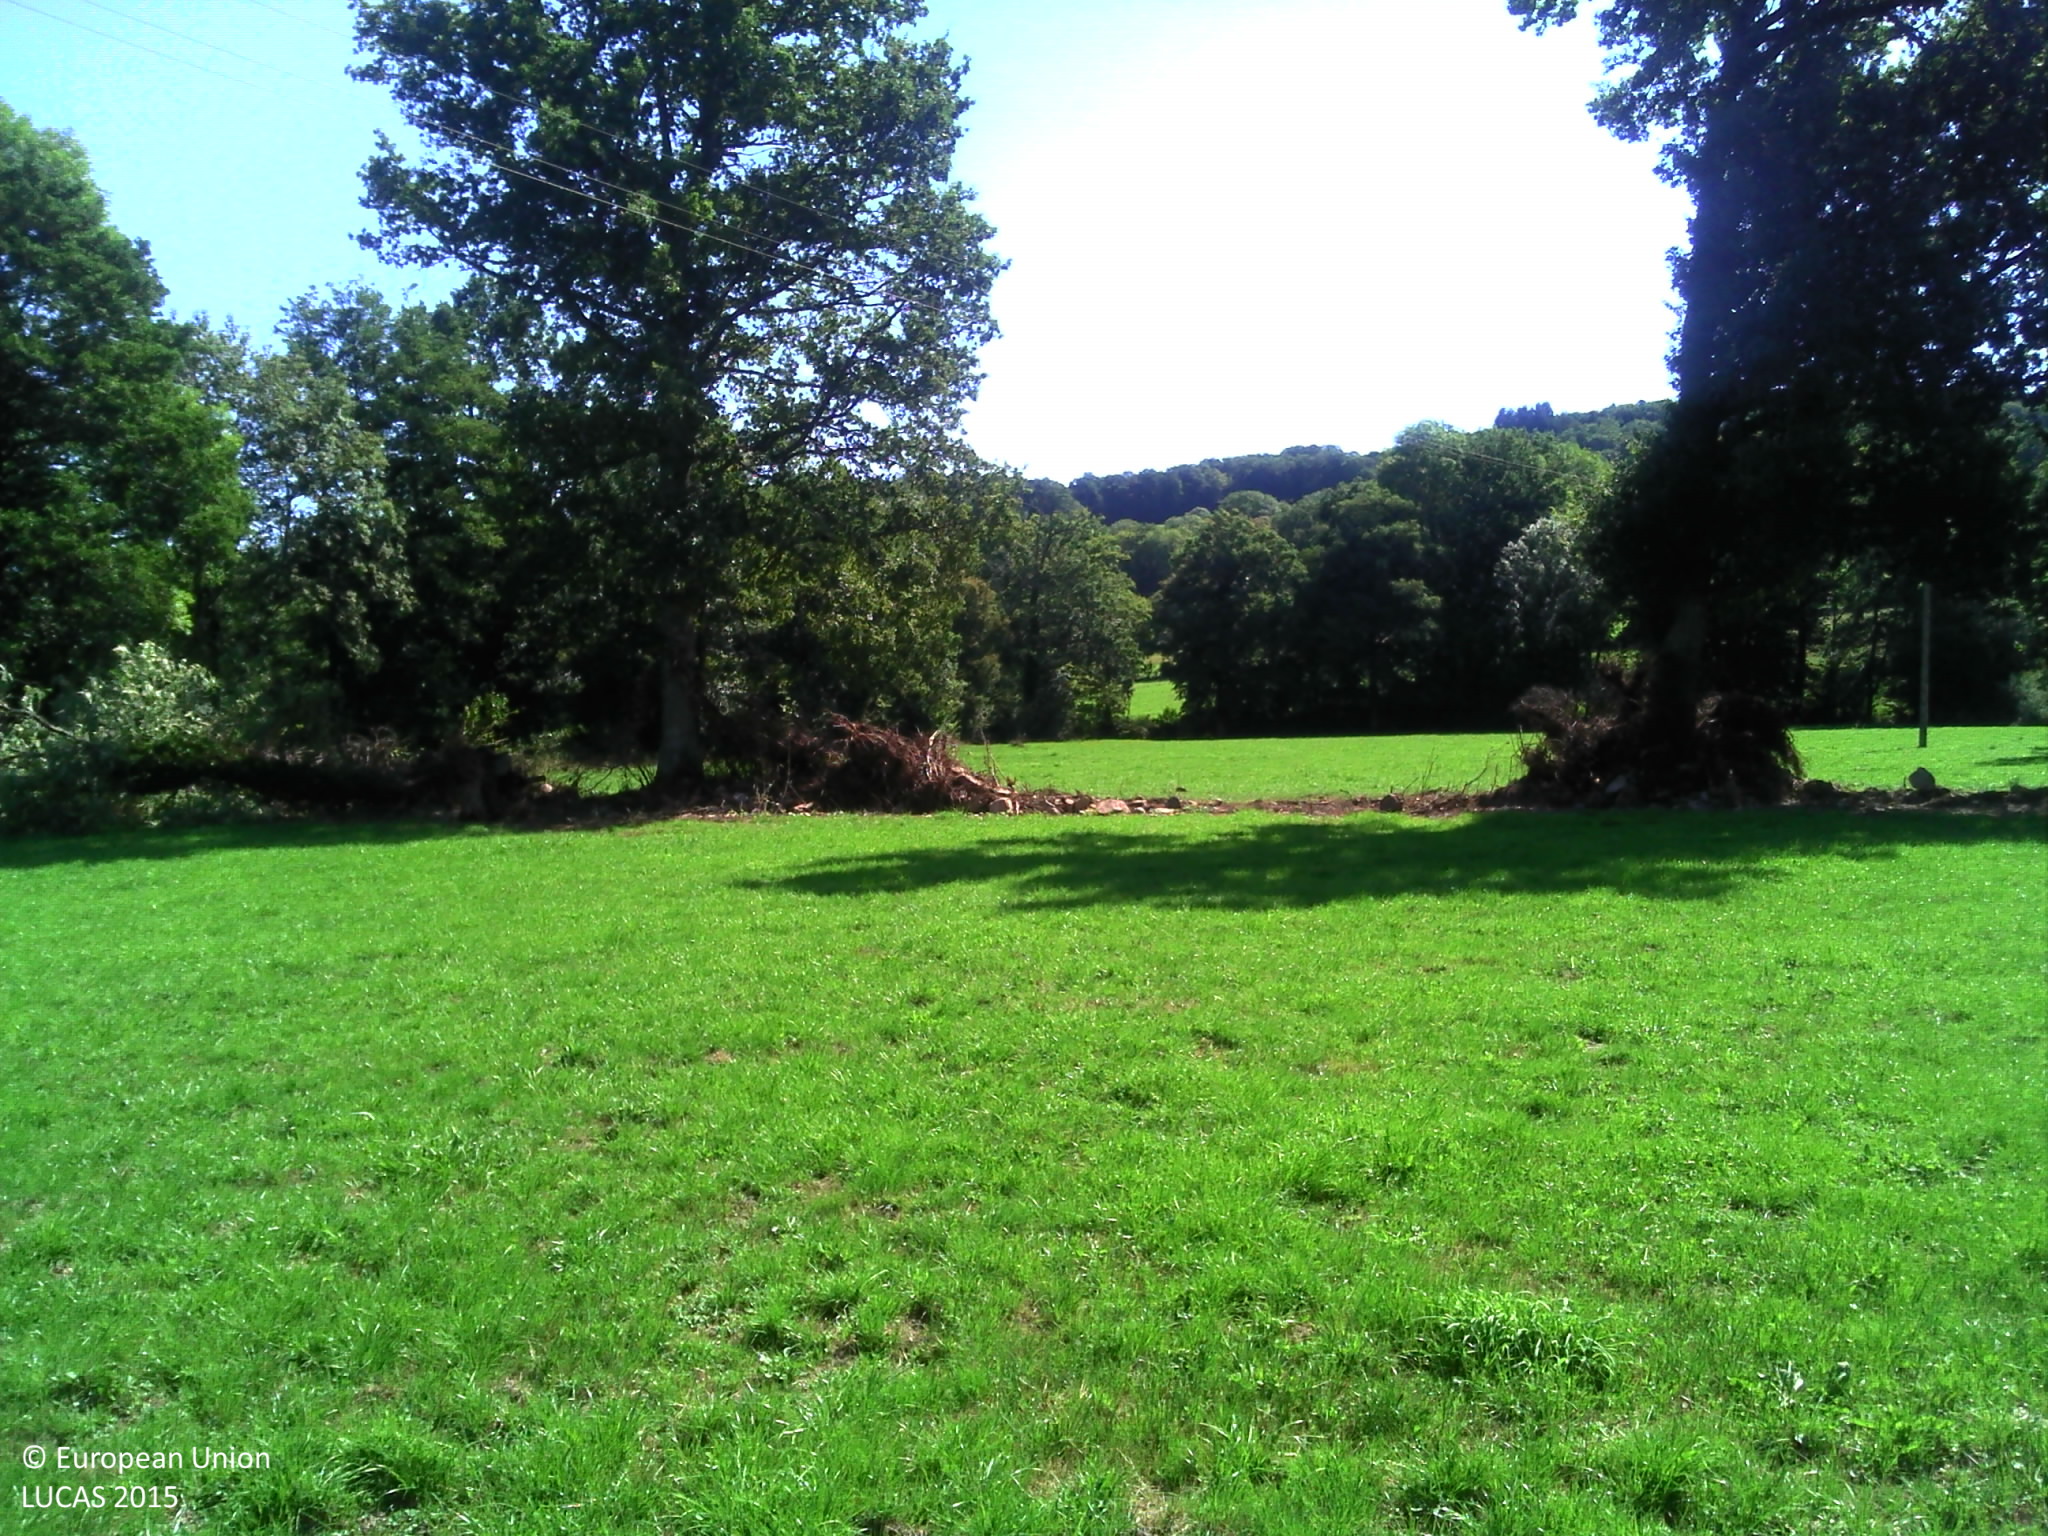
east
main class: Grassland
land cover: Grassland without tree/shrub cover
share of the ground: > 75 %
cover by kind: herbaceous plants 100 %
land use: Agriculture (excluding fallow land and kitchen gardens)
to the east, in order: Grassland without tree/shrub cover; Other bare soil; Electric lines; Grassland without tree/shrub cover; Fences; Rivers and streams; Broadleaved woodland; Fences; Grassland without tree/shrub cover; Fences; Broadleaved woodland; Inland fresh running water; Abandoned hedges; Fences; Grassland without tree/shrub cover; Ditches and canals; Grassland without tree/shrub cover
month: August
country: FR
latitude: 45.9464
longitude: 2.2947
